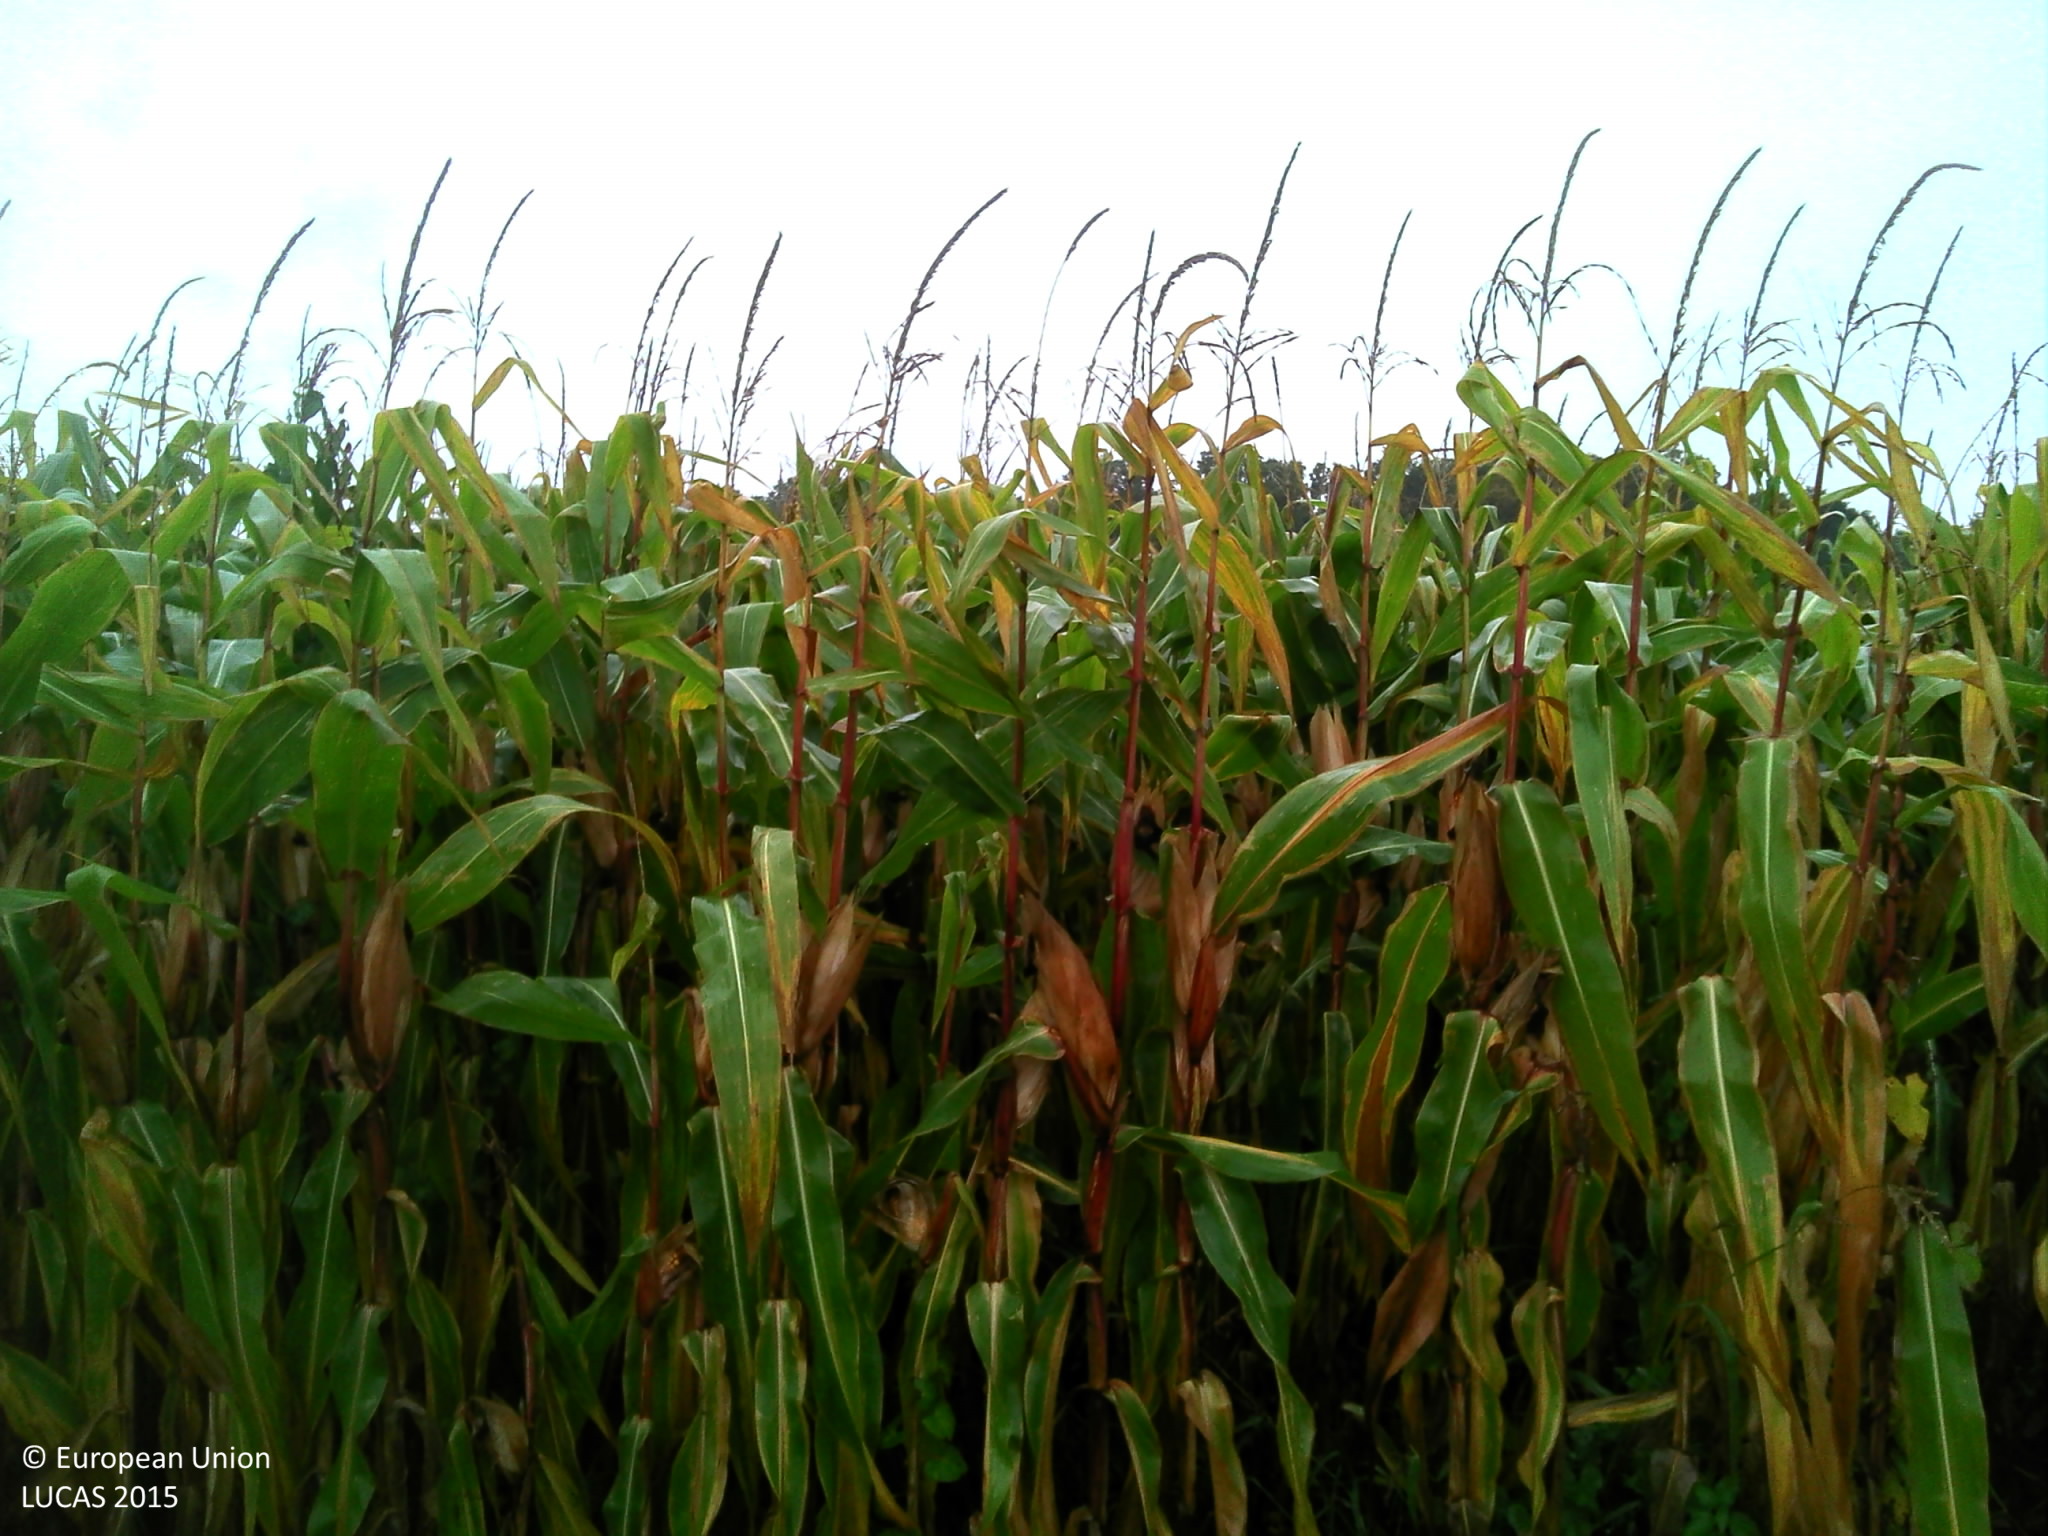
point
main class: Cropland
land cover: Maize
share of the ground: > 75 %
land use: Agriculture (excluding fallow land and kitchen gardens)
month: October
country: BE
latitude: 50.9207
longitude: 2.9195
